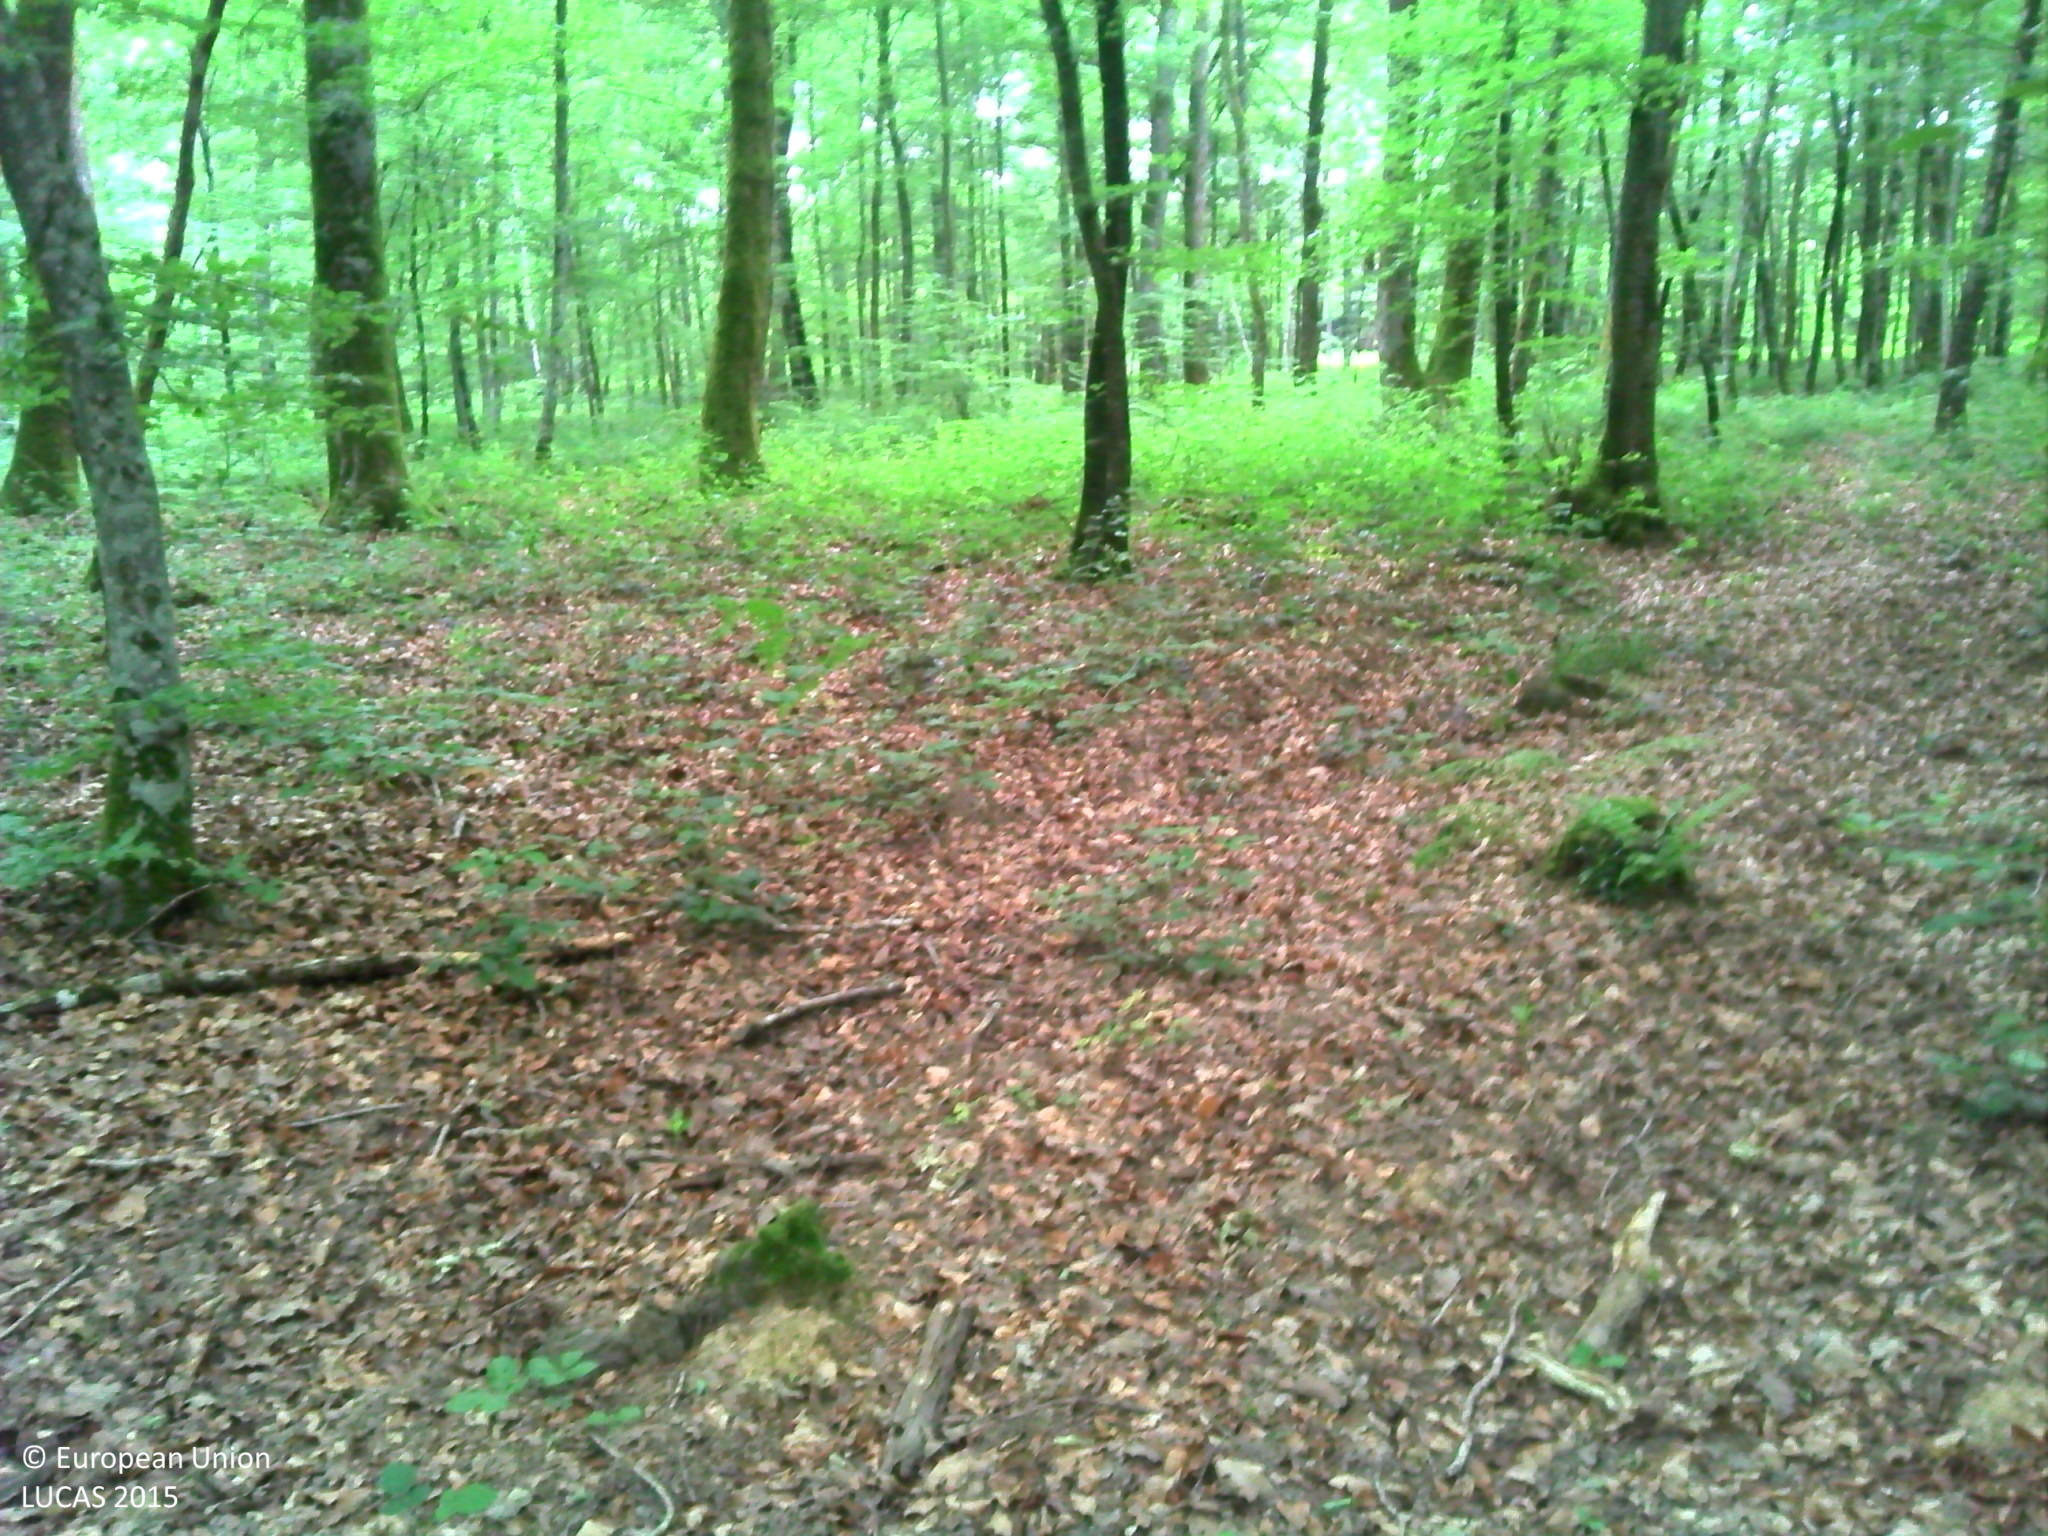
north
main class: Woodland
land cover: Broadleaved woodland
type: beech forest
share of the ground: > 75 %
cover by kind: broadleaved forest trees 95 %, herbaceous plants 5 %
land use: Forestry
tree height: > 5 m
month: June
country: FR
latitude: 47.7409
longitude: 6.1202
